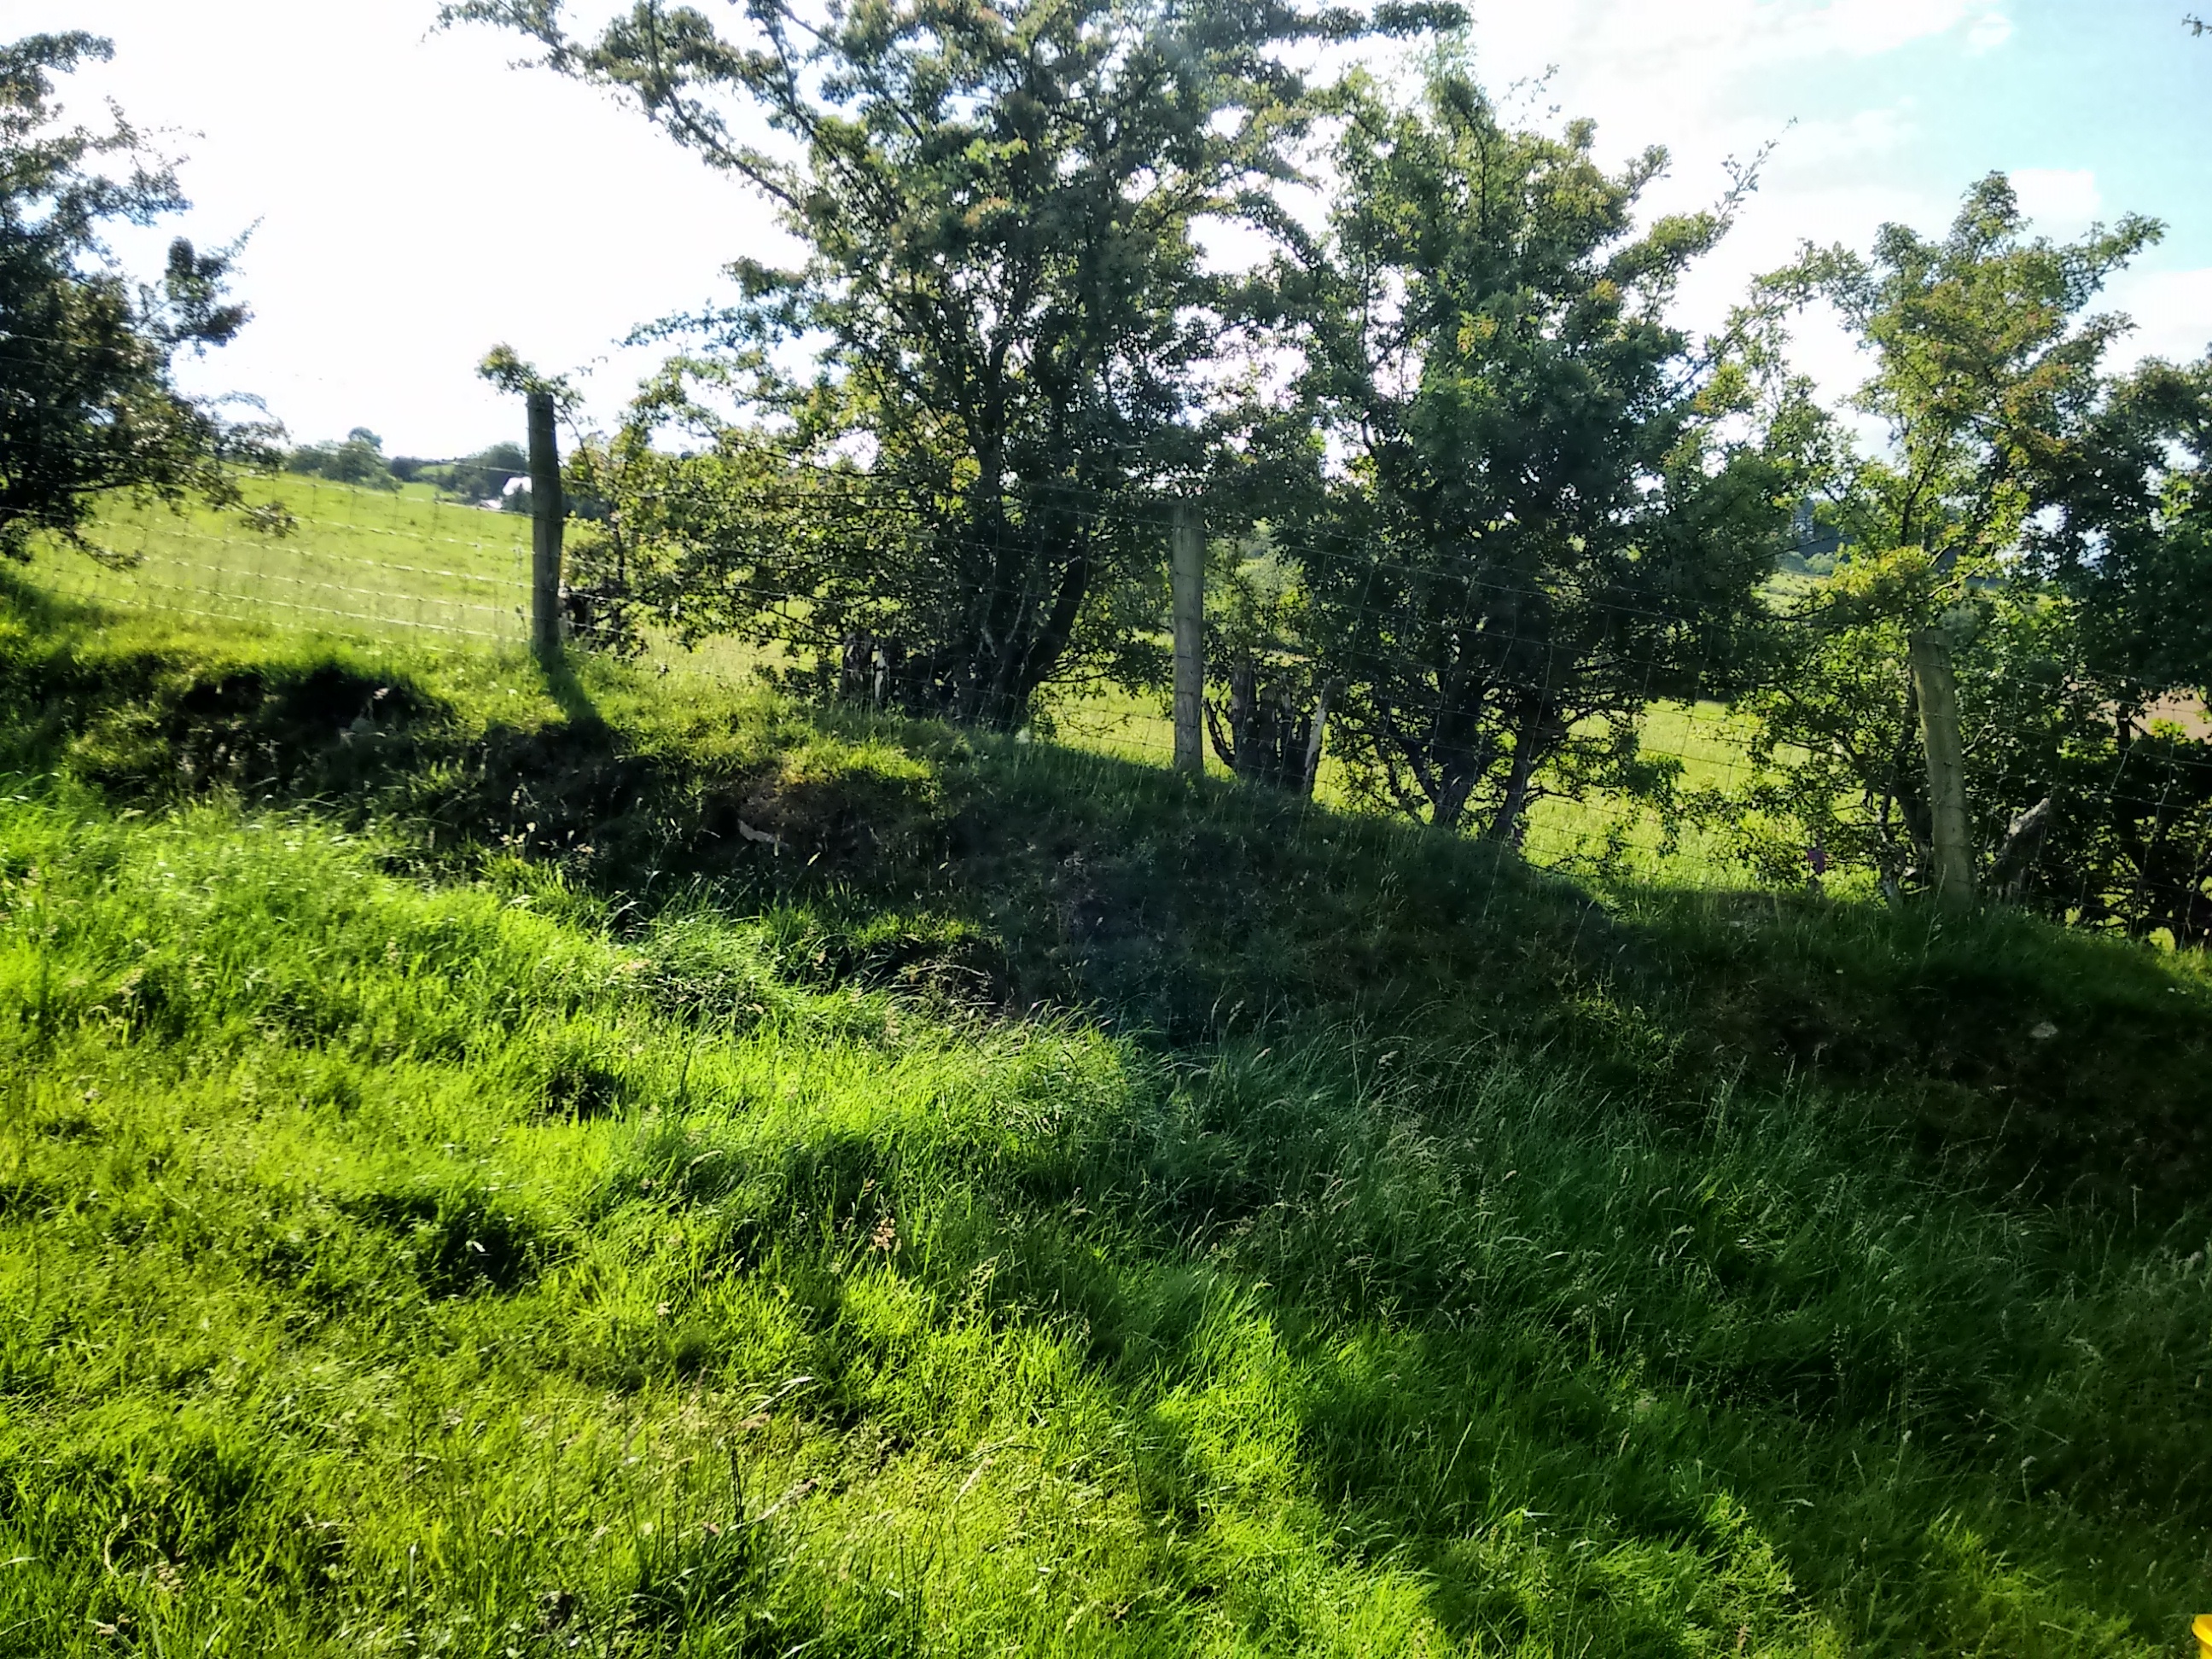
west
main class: Grassland
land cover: Grassland without tree/shrub cover
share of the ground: > 75 %
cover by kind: herbaceous plants 100 %
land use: Agriculture (excluding fallow land and kitchen gardens)
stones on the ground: 25 - 50 %
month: July
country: GB
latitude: 54.7601
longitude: -7.1605
